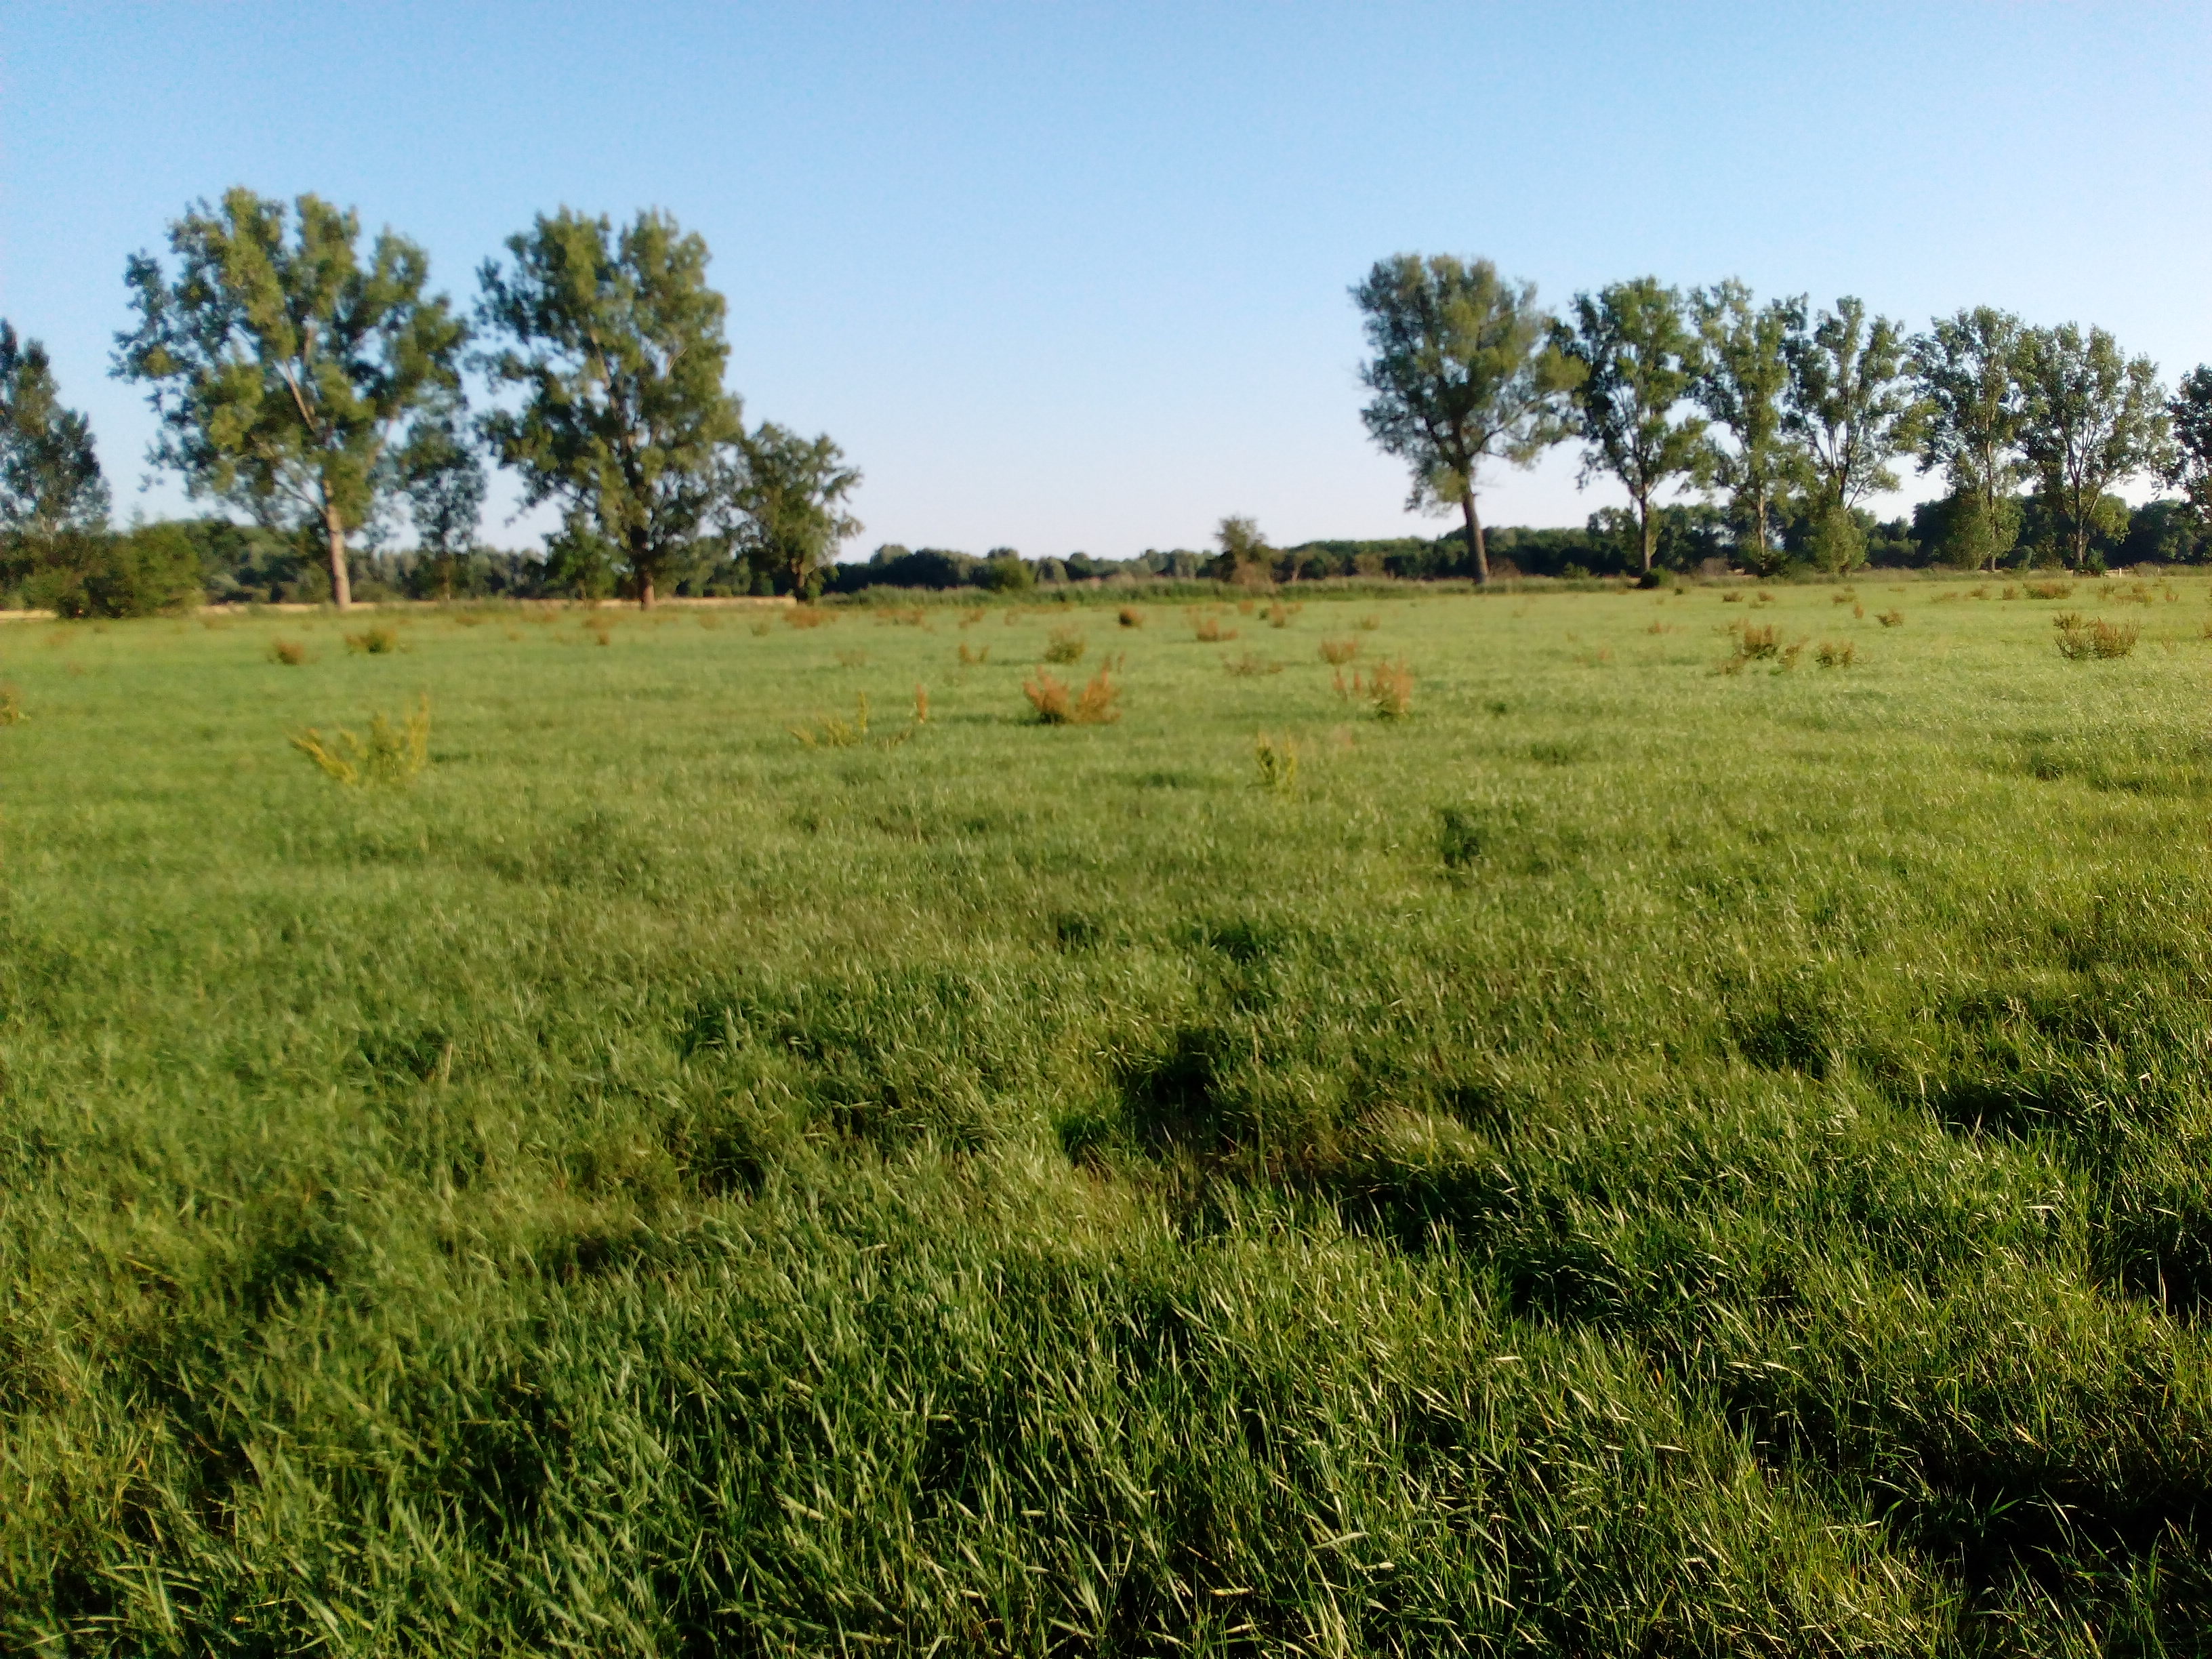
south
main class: Grassland
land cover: Grassland without tree/shrub cover
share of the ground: > 75 %
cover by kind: herbaceous plants 100 %
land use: Agriculture (excluding fallow land and kitchen gardens)
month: July
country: DE
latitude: 51.1334
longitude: 10.9286
